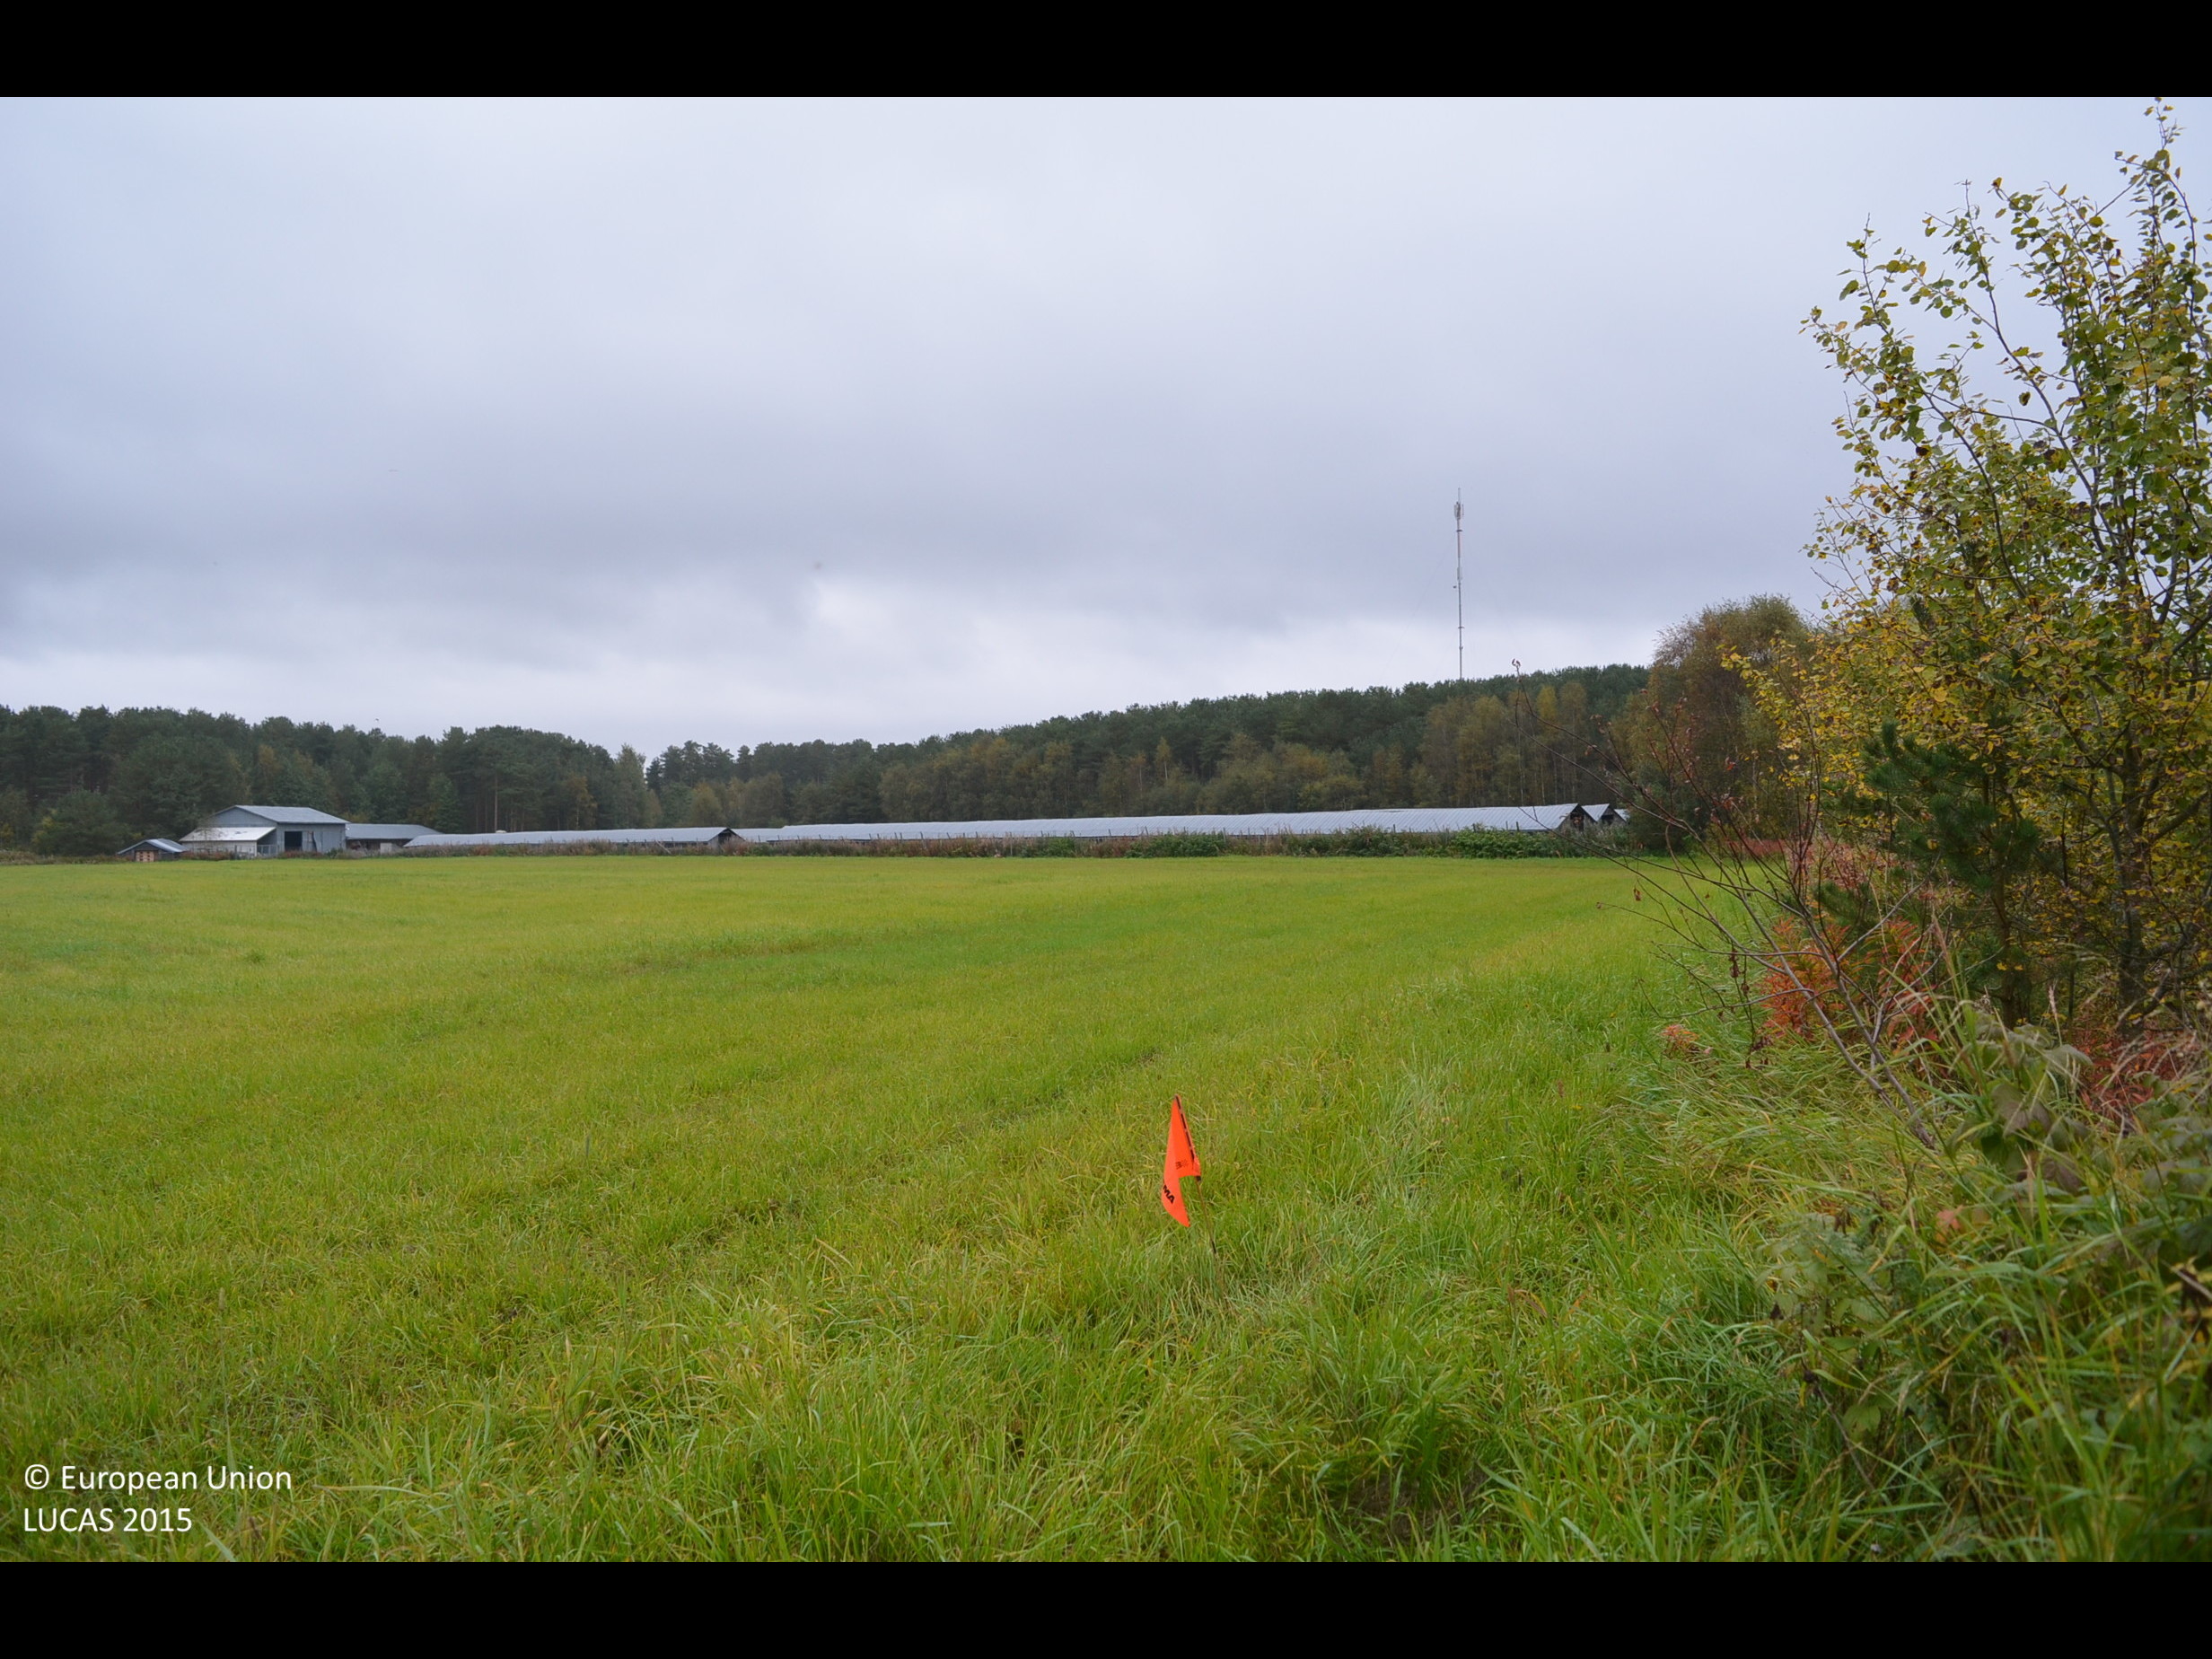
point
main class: Cropland
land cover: Temporary grasslands
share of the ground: > 75 %
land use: Agriculture (excluding fallow land and kitchen gardens)
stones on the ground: < 10 %
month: September
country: FI
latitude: 62.9347
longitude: 23.7229
